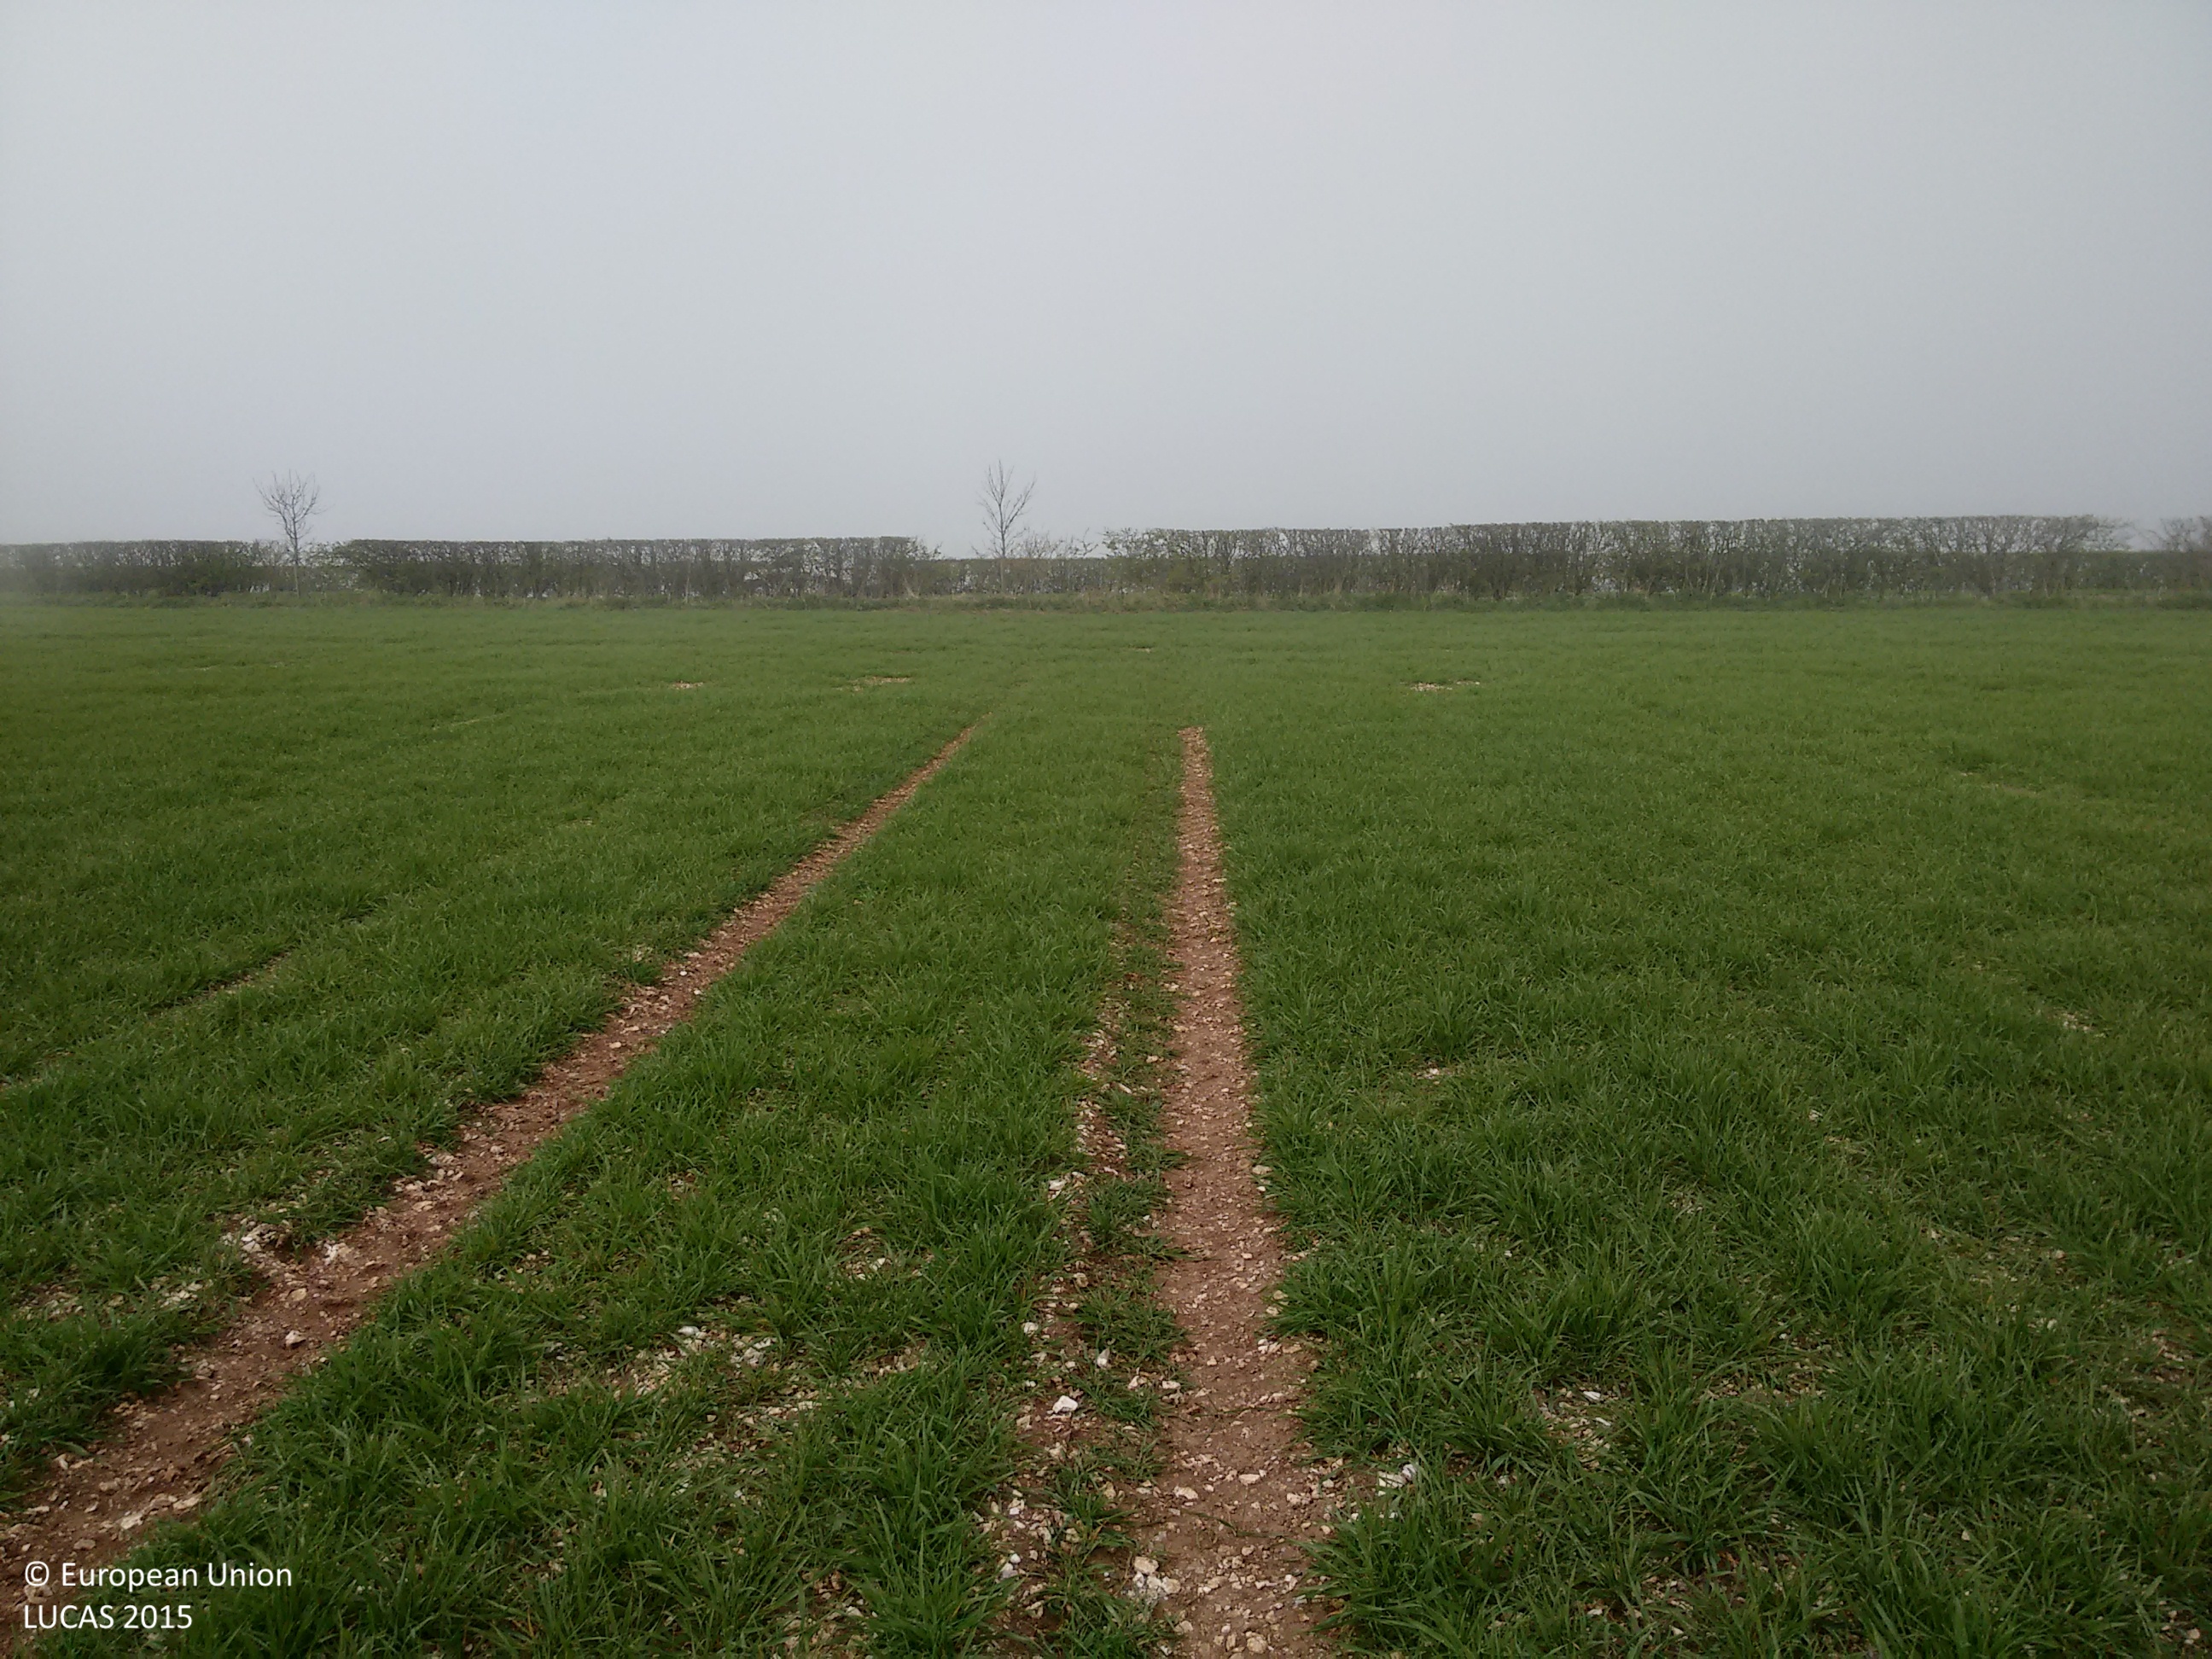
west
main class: Cropland
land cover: Barley
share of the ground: > 75 %
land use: Agriculture (excluding fallow land and kitchen gardens)
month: April
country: GB
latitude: 53.9914
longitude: -0.7622
